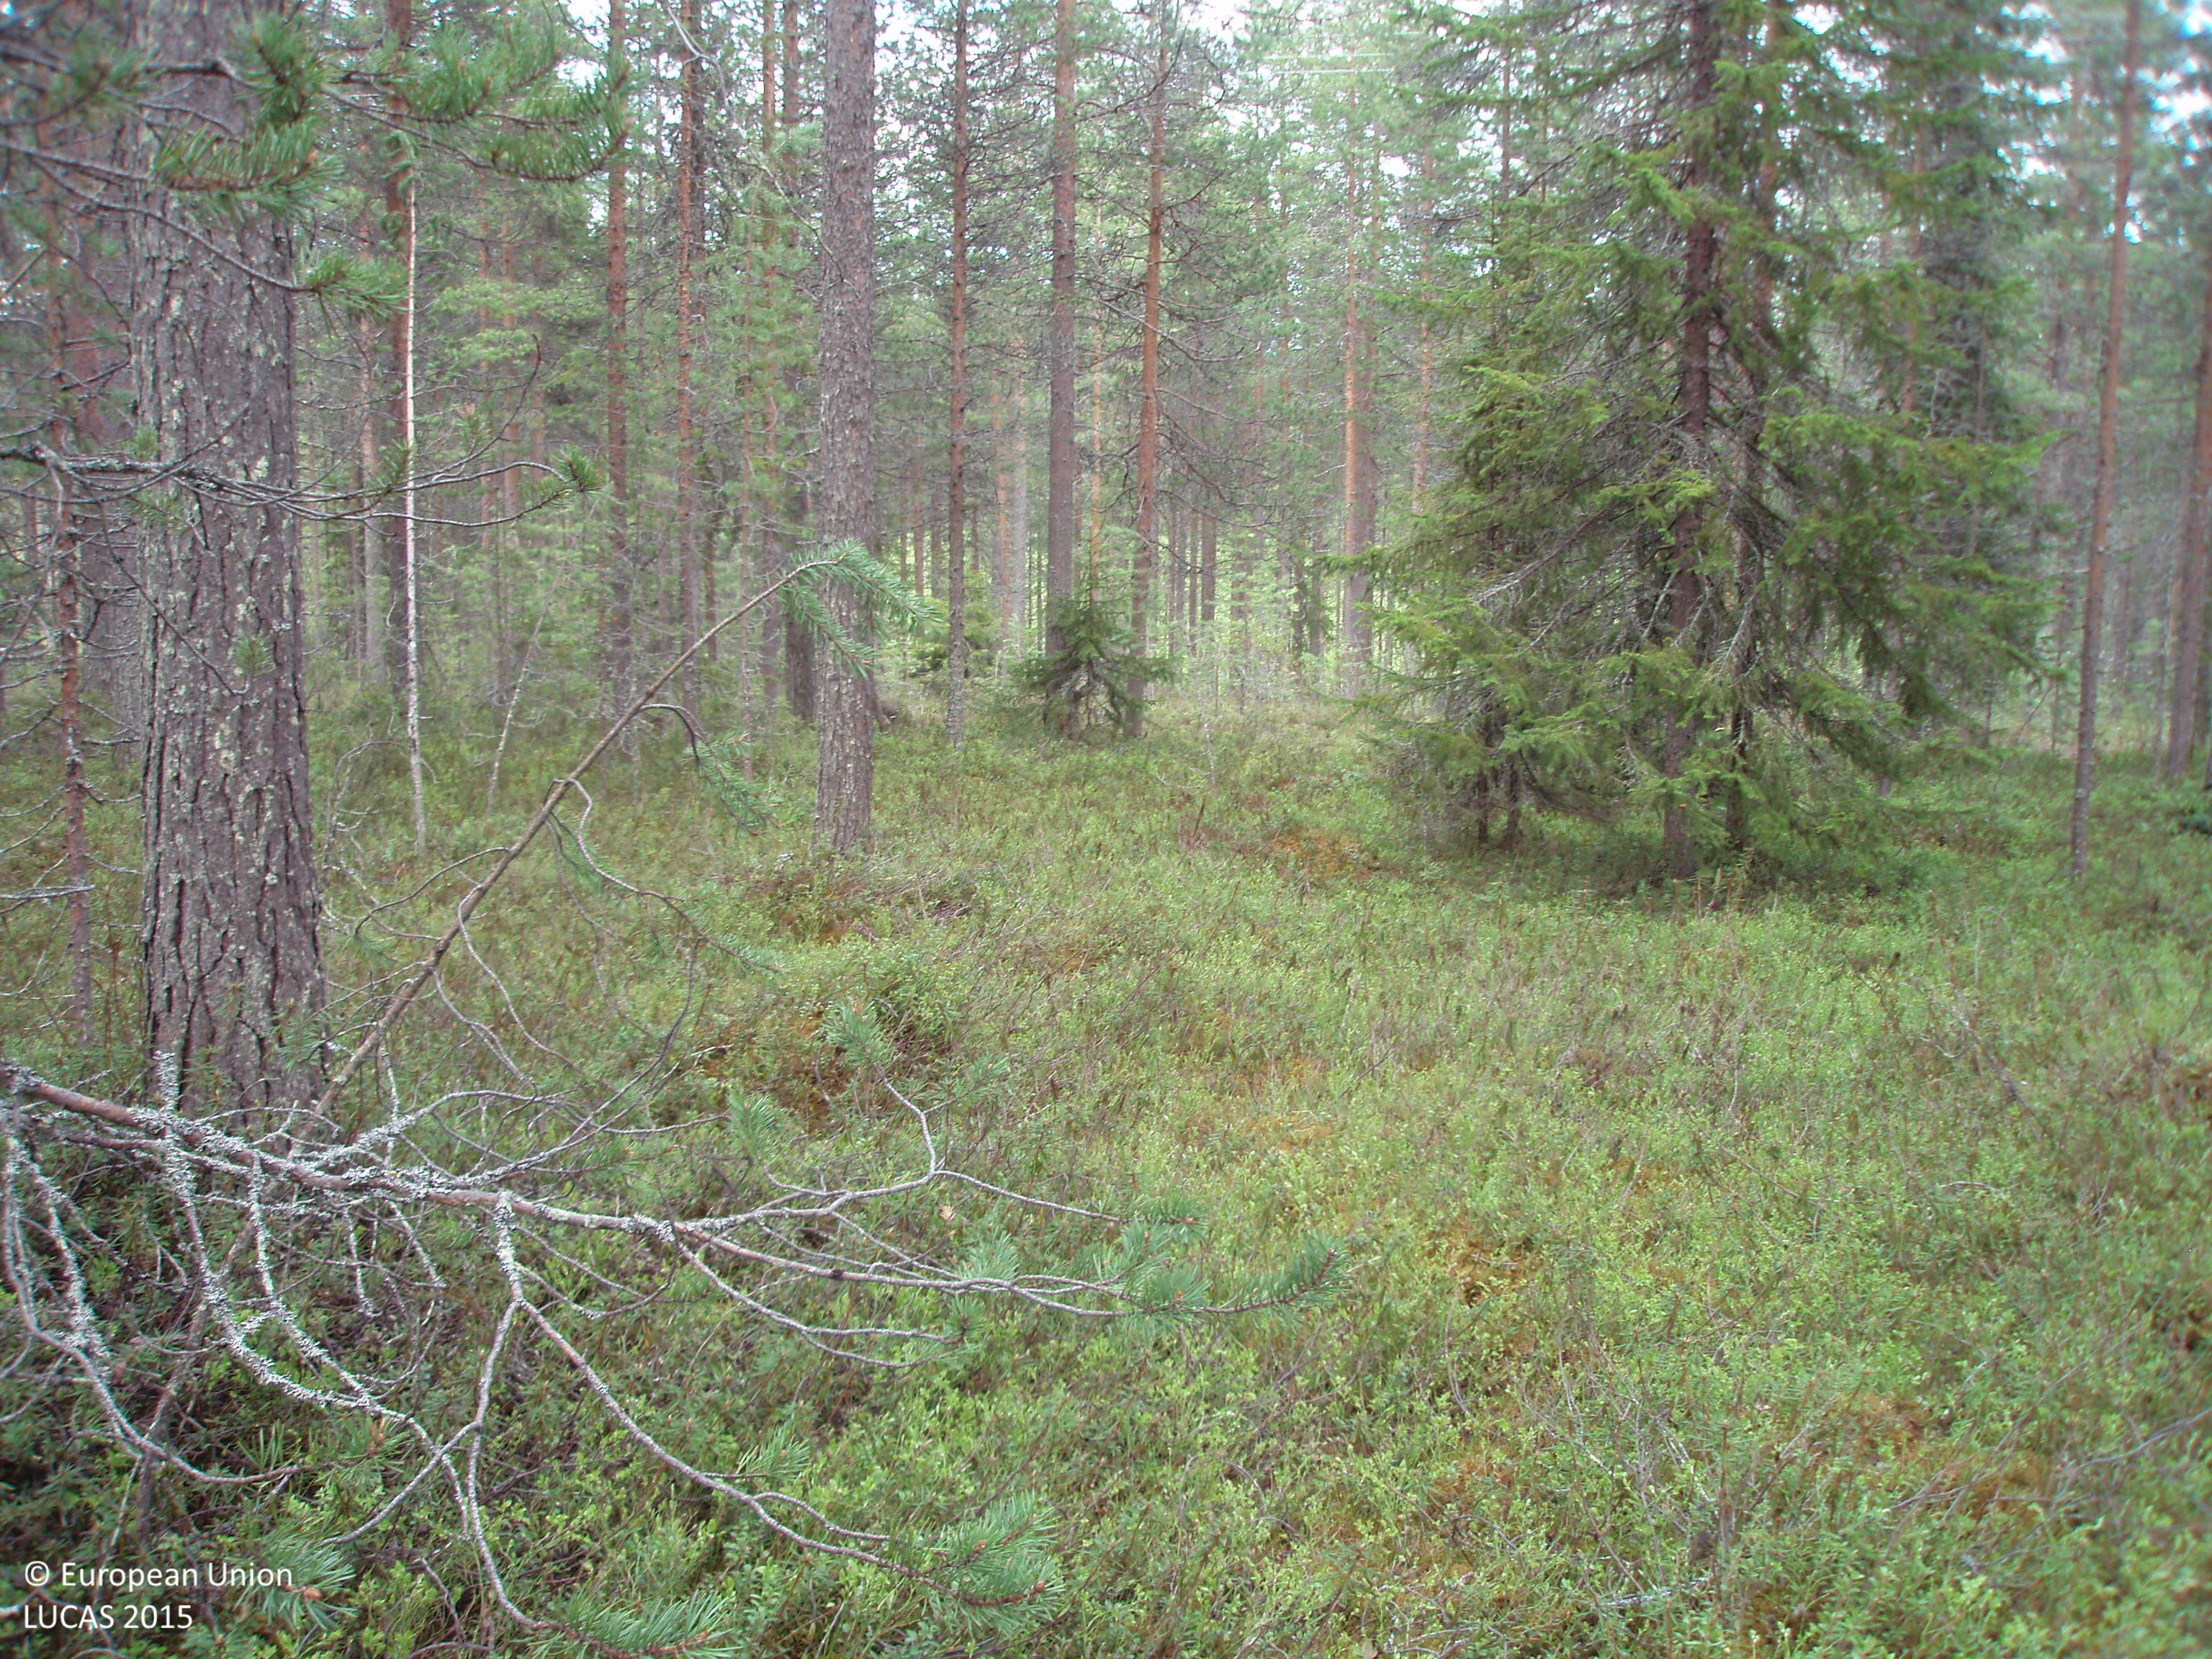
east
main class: Woodland
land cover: Pine dominated coniferous woodland
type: boreal forest
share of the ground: > 75 %
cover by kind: coniferous forest trees 85 %, shrubs 15 %
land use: Forestry
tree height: > 5 m
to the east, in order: Pine dominated coniferous woodland; Shruby margins; Electric lines; Shruby margins; Pine dominated coniferous woodland; Electric lines; Grass margins; Ditches and canals; Paved roads, cycling and walking lanes; Grass margins; Pine dominated coniferous woodland; Fences; Pine dominated coniferous woodland; Pine dominated mixed woodland; Ditches and canals; Grassland without tree/shrub cover; Other bare soil; Ditches and canals; Temporary grasslands; Ditches and canals; Temporary grasslands
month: June
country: FI
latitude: 66.7038
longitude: 27.5837
